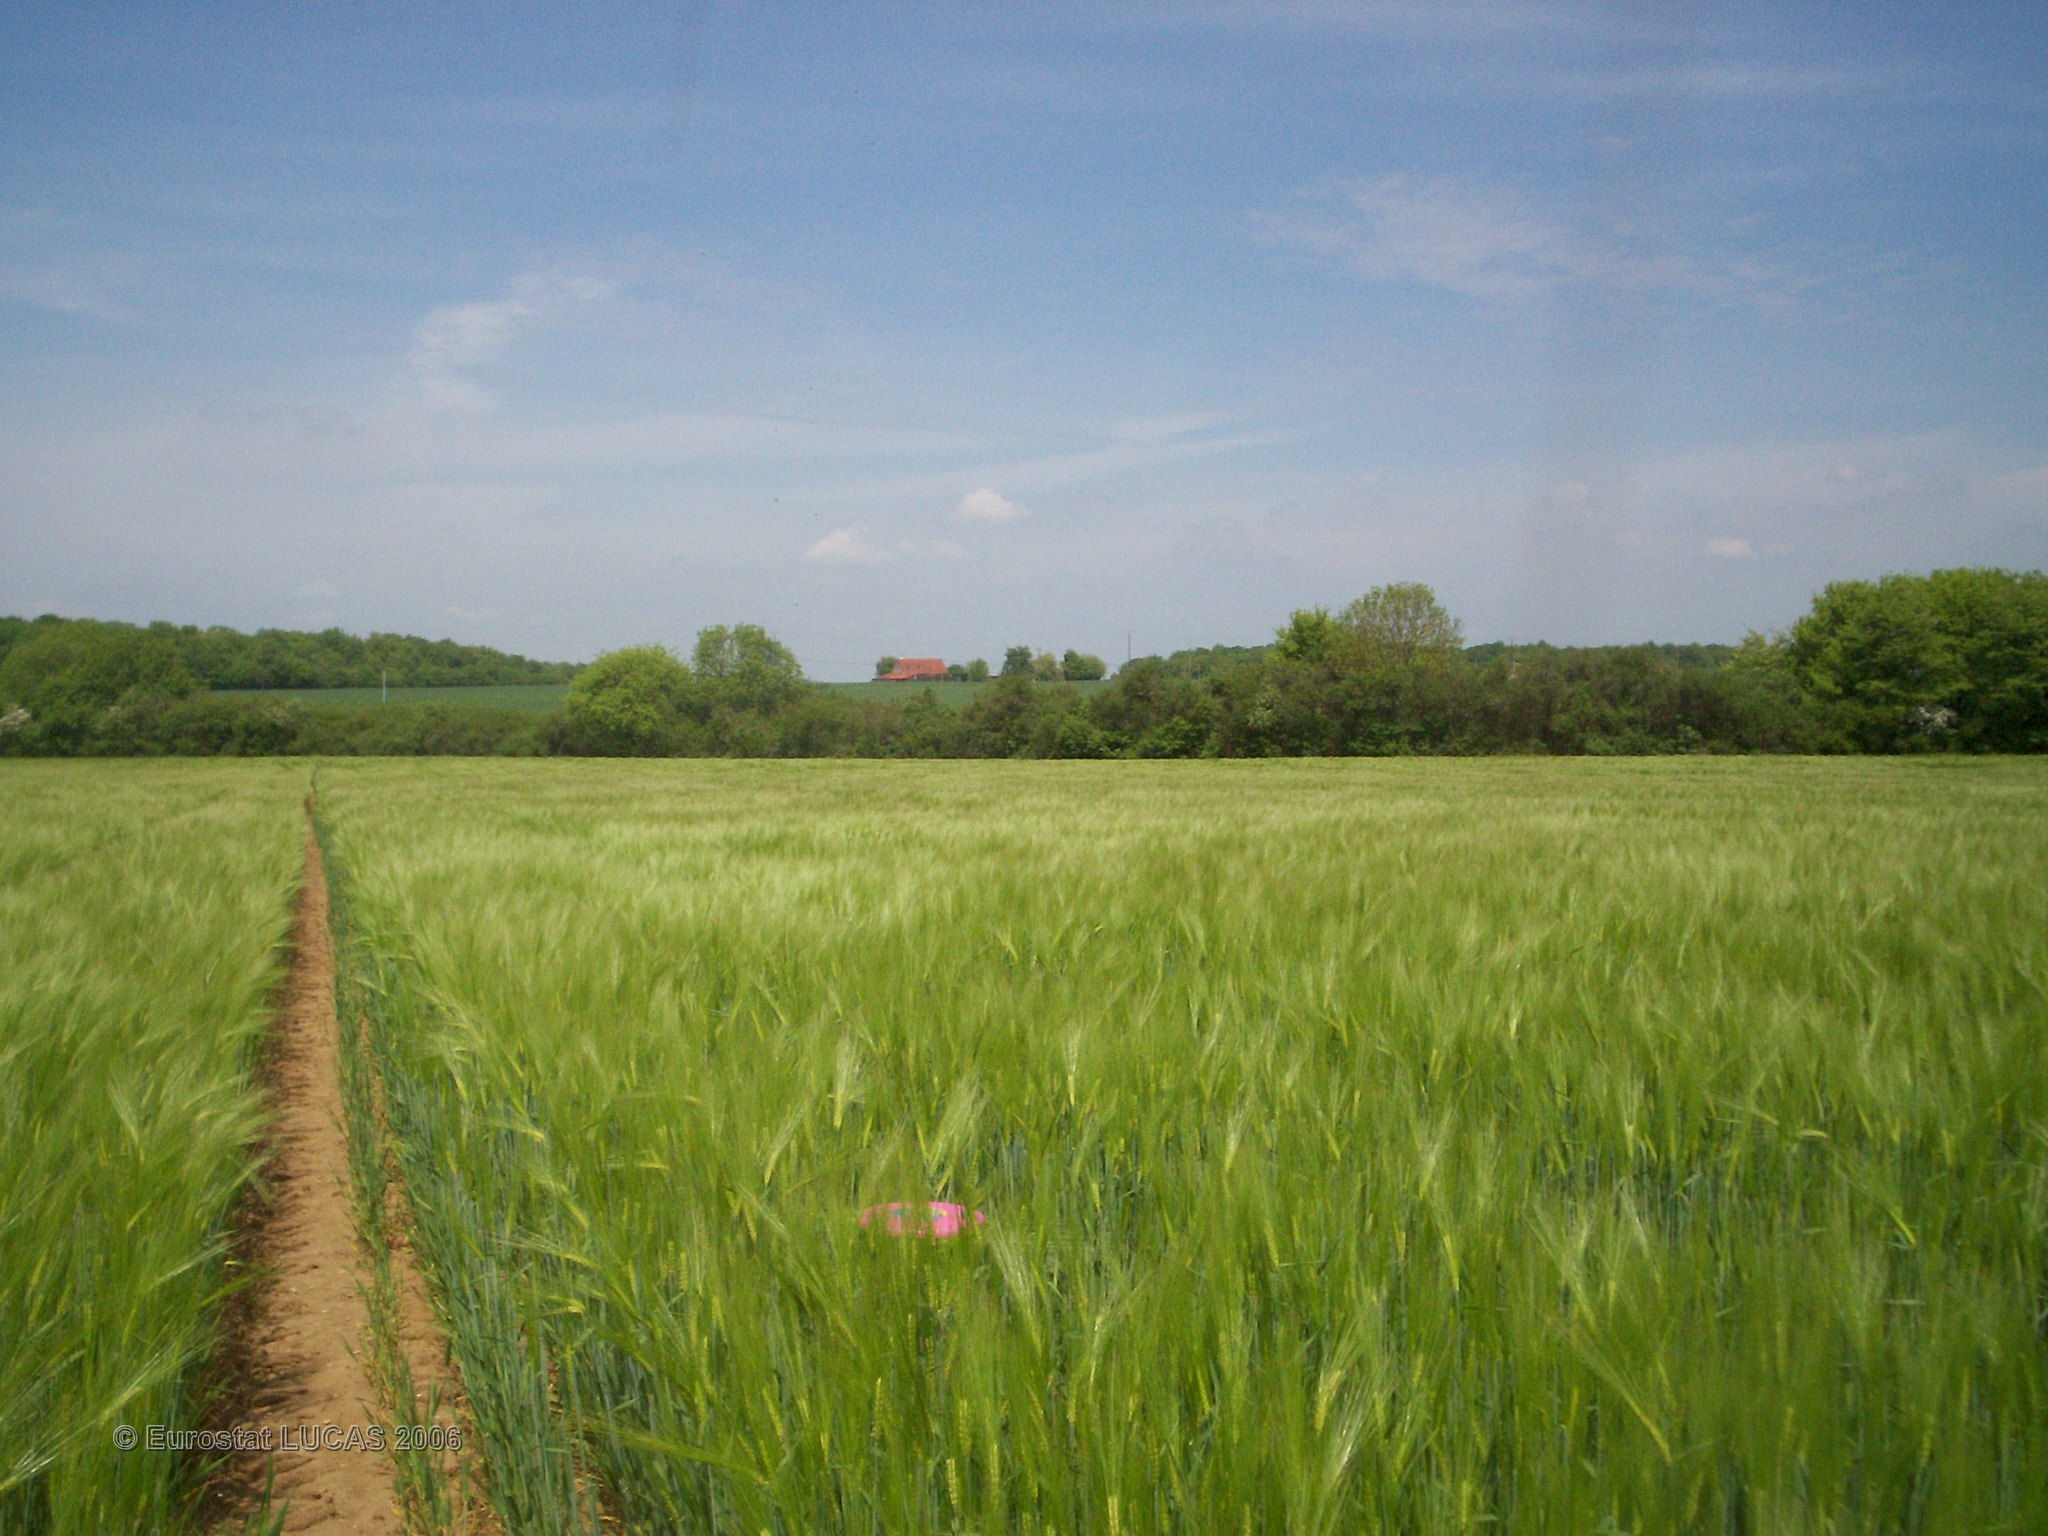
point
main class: Cropland
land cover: Barley
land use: Agriculture (excluding fallow land and kitchen gardens)
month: May
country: FR
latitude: 47.6563
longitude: 2.9769
